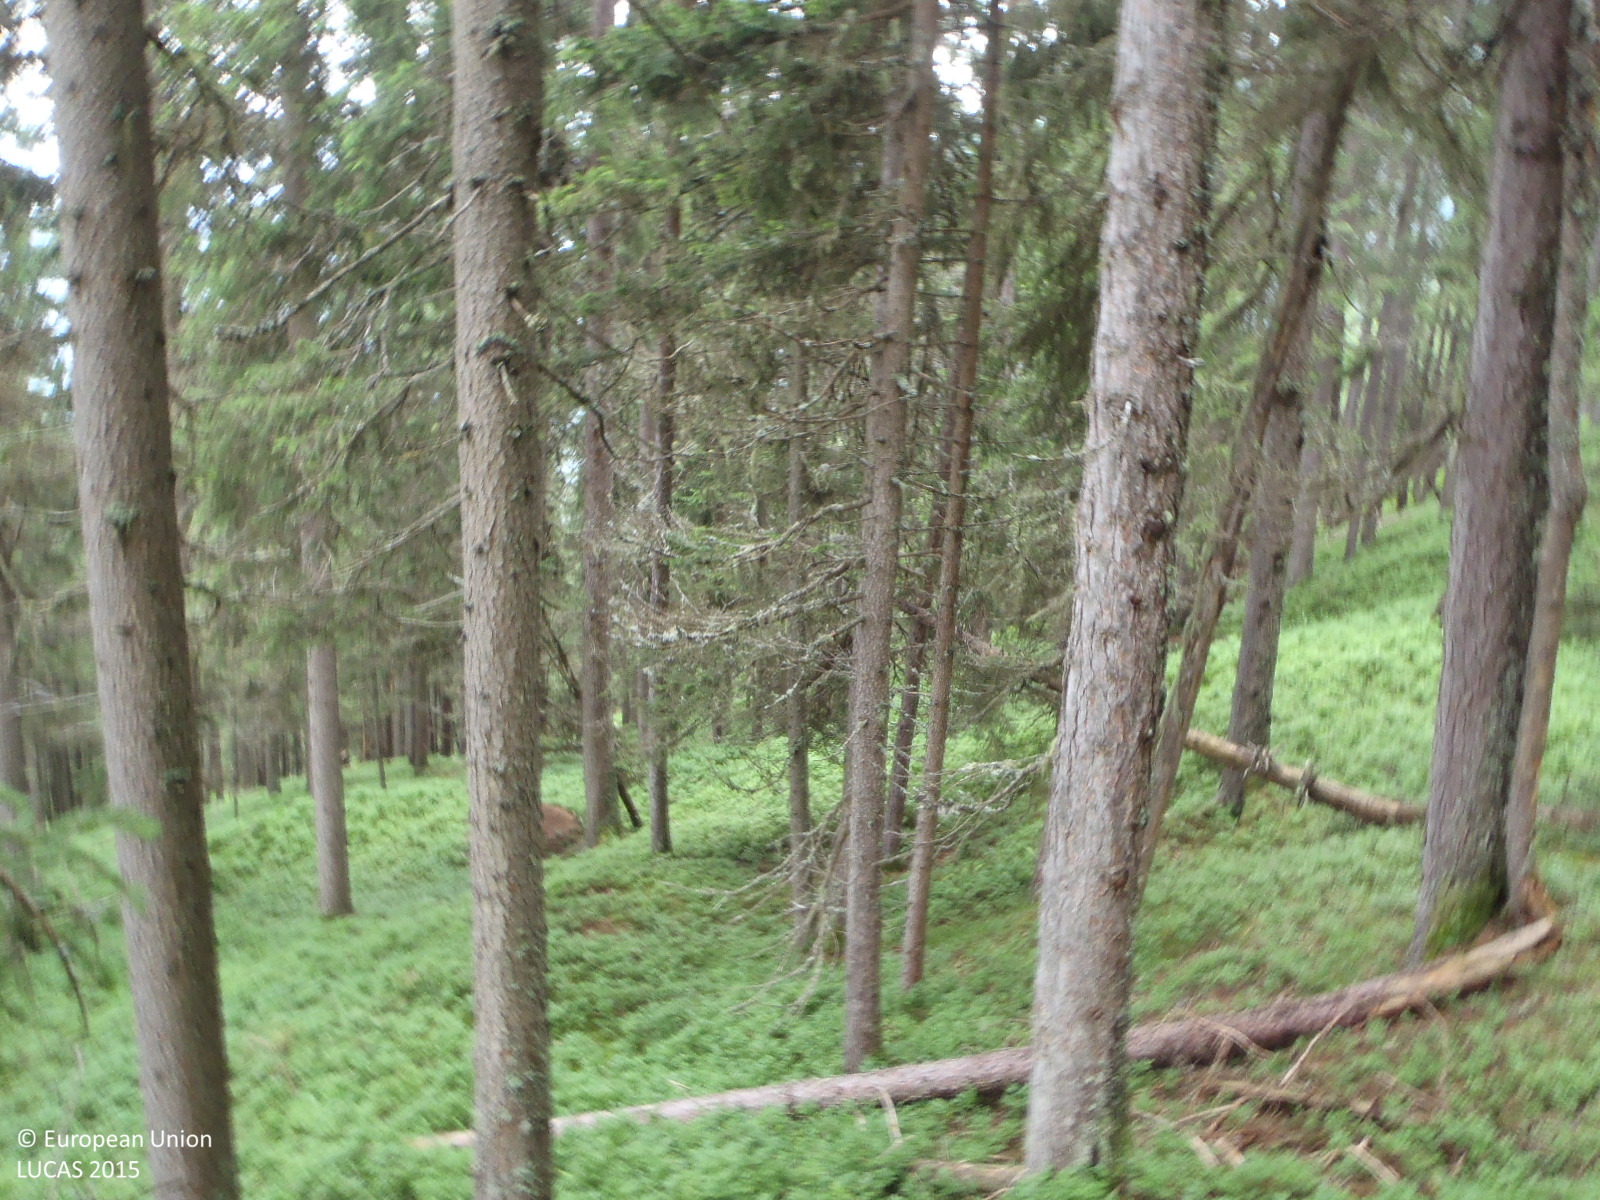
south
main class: Woodland
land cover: Spruce dominated coniferous woodland
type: alpine coniferous forest
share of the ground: > 75 %
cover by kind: coniferous forest trees 90 %, shrubs 10 %
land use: Forestry
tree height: > 5 m
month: July
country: AT
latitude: 47.3445
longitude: 11.8119
